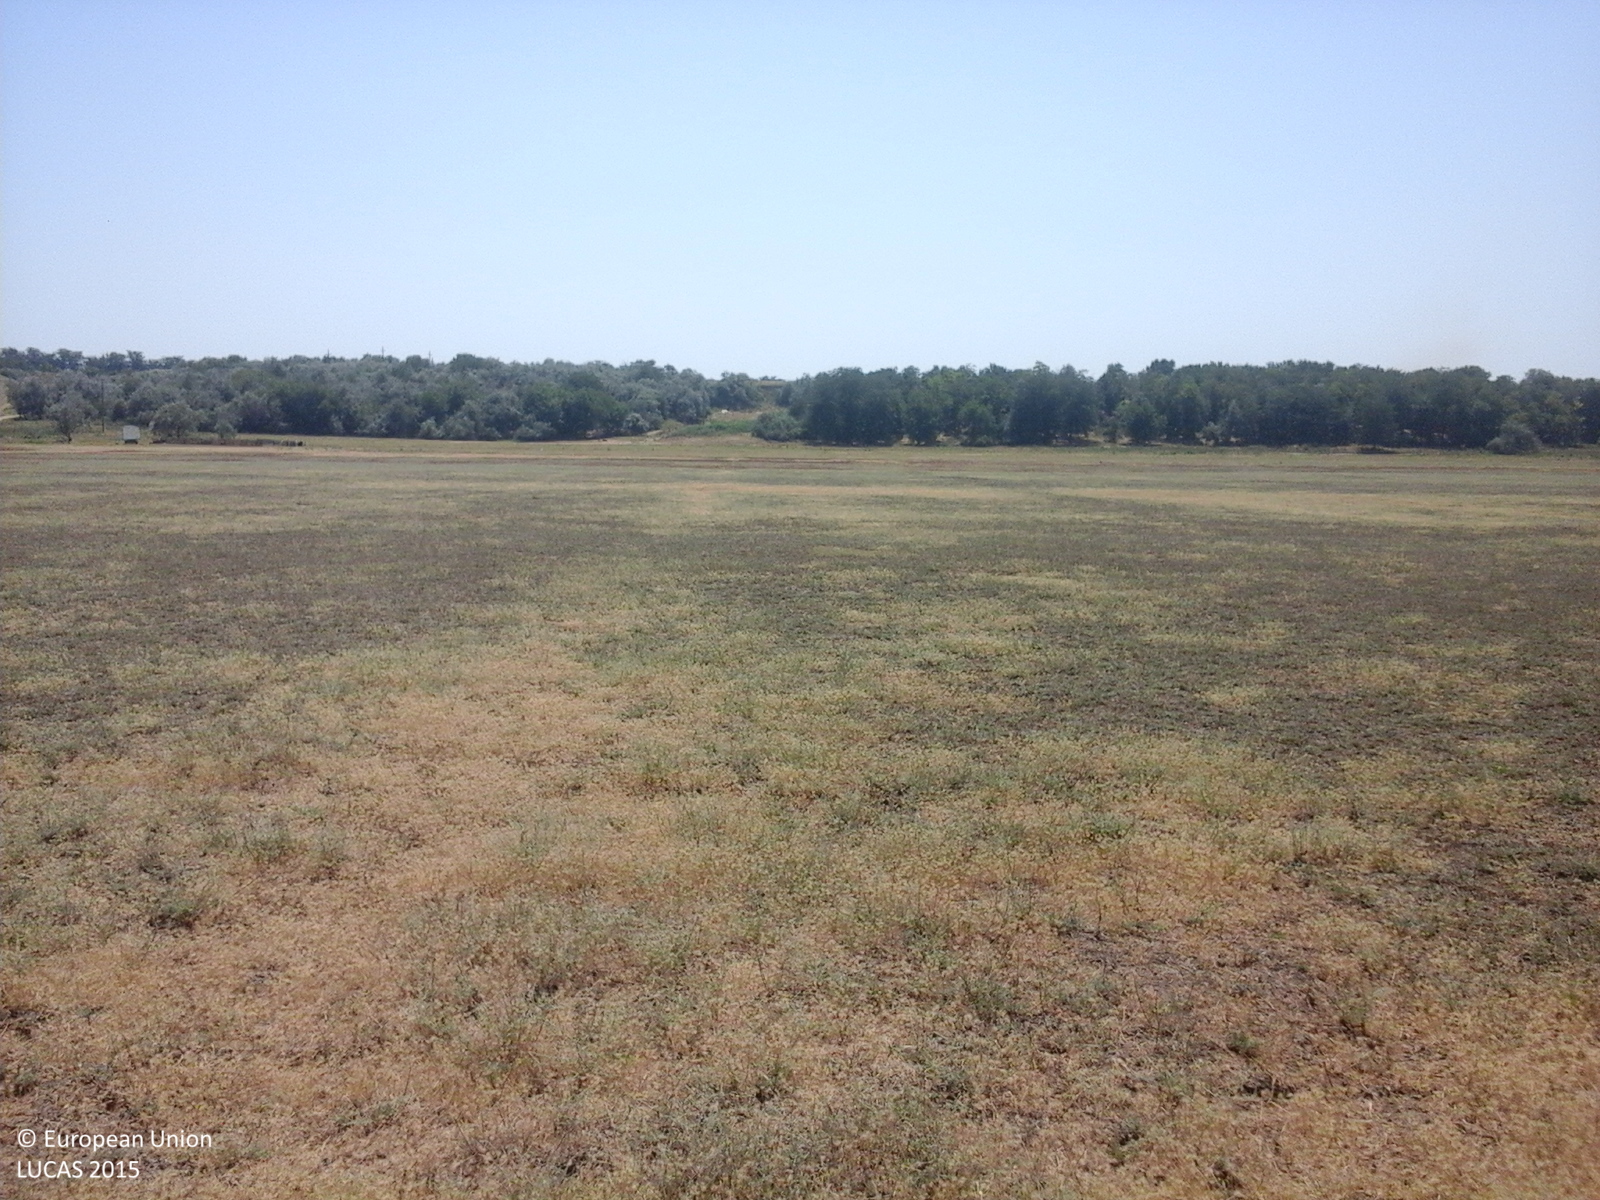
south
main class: Grassland
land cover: Grassland without tree/shrub cover
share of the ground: > 75 %
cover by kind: herbaceous plants 100 %
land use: Agriculture (excluding fallow land and kitchen gardens)
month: July
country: RO
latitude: 44.5663
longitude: 27.5850
